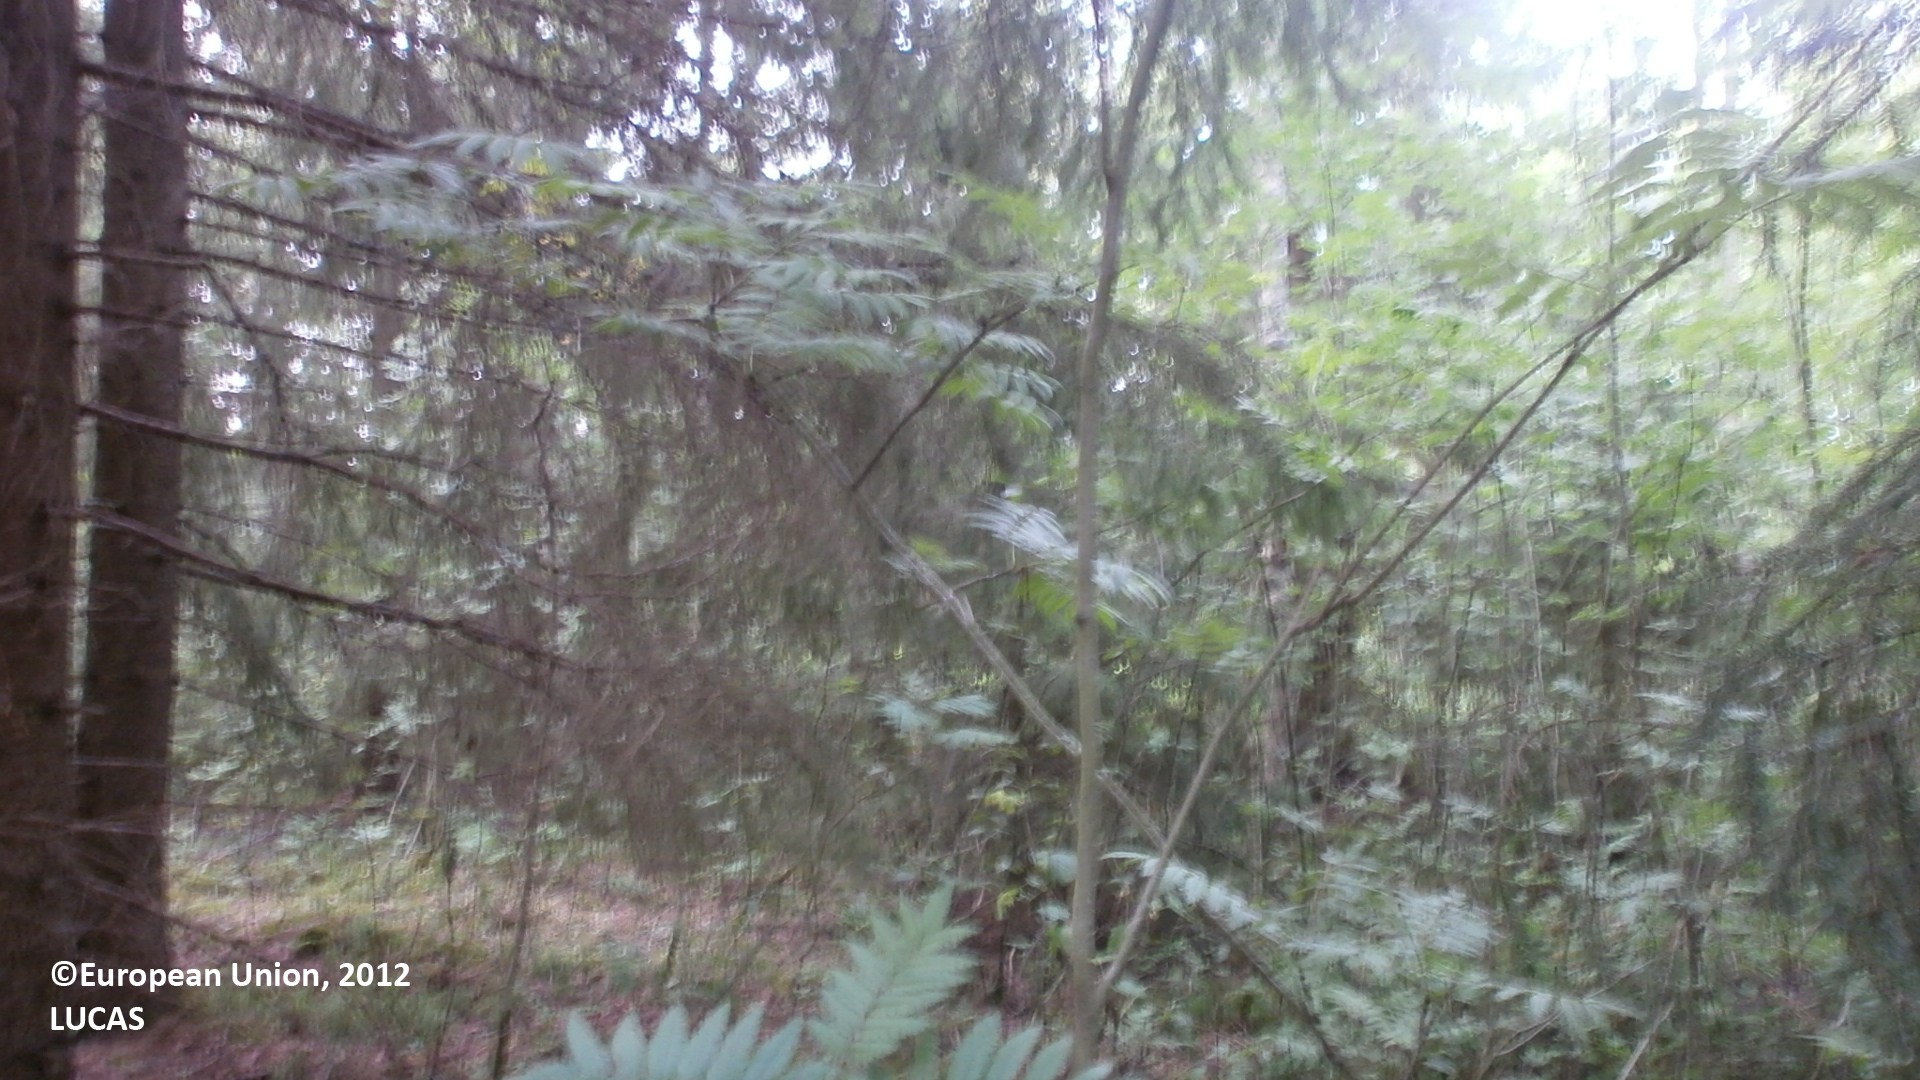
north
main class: Woodland
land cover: Spruce dominated mixed woodland
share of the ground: > 75 %
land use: Forestry
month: July
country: FI
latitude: 64.3046
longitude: 24.4365
